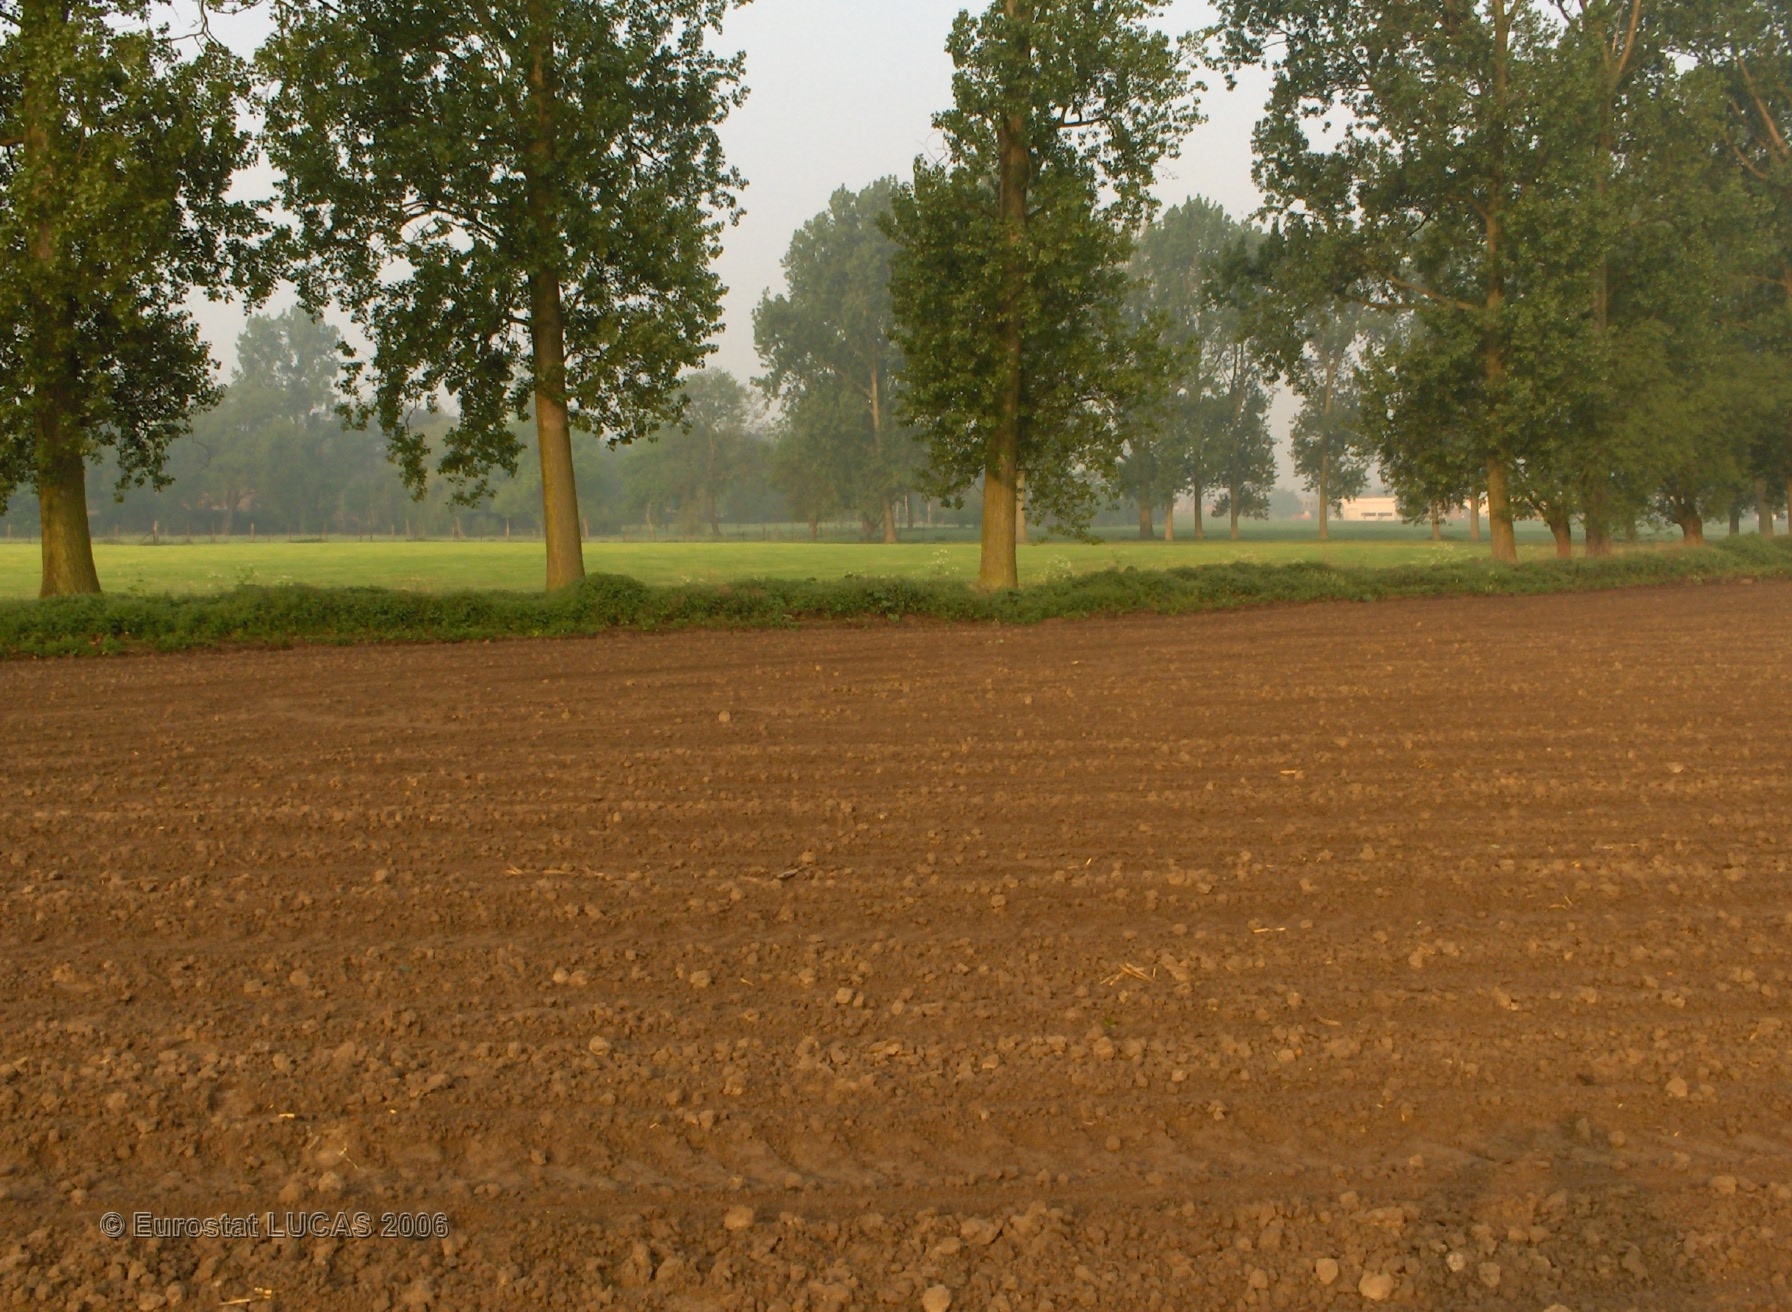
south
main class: Cropland
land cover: Maize
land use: Agriculture (excluding fallow land and kitchen gardens)
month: May
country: BE
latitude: 51.1464
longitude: 4.4062
